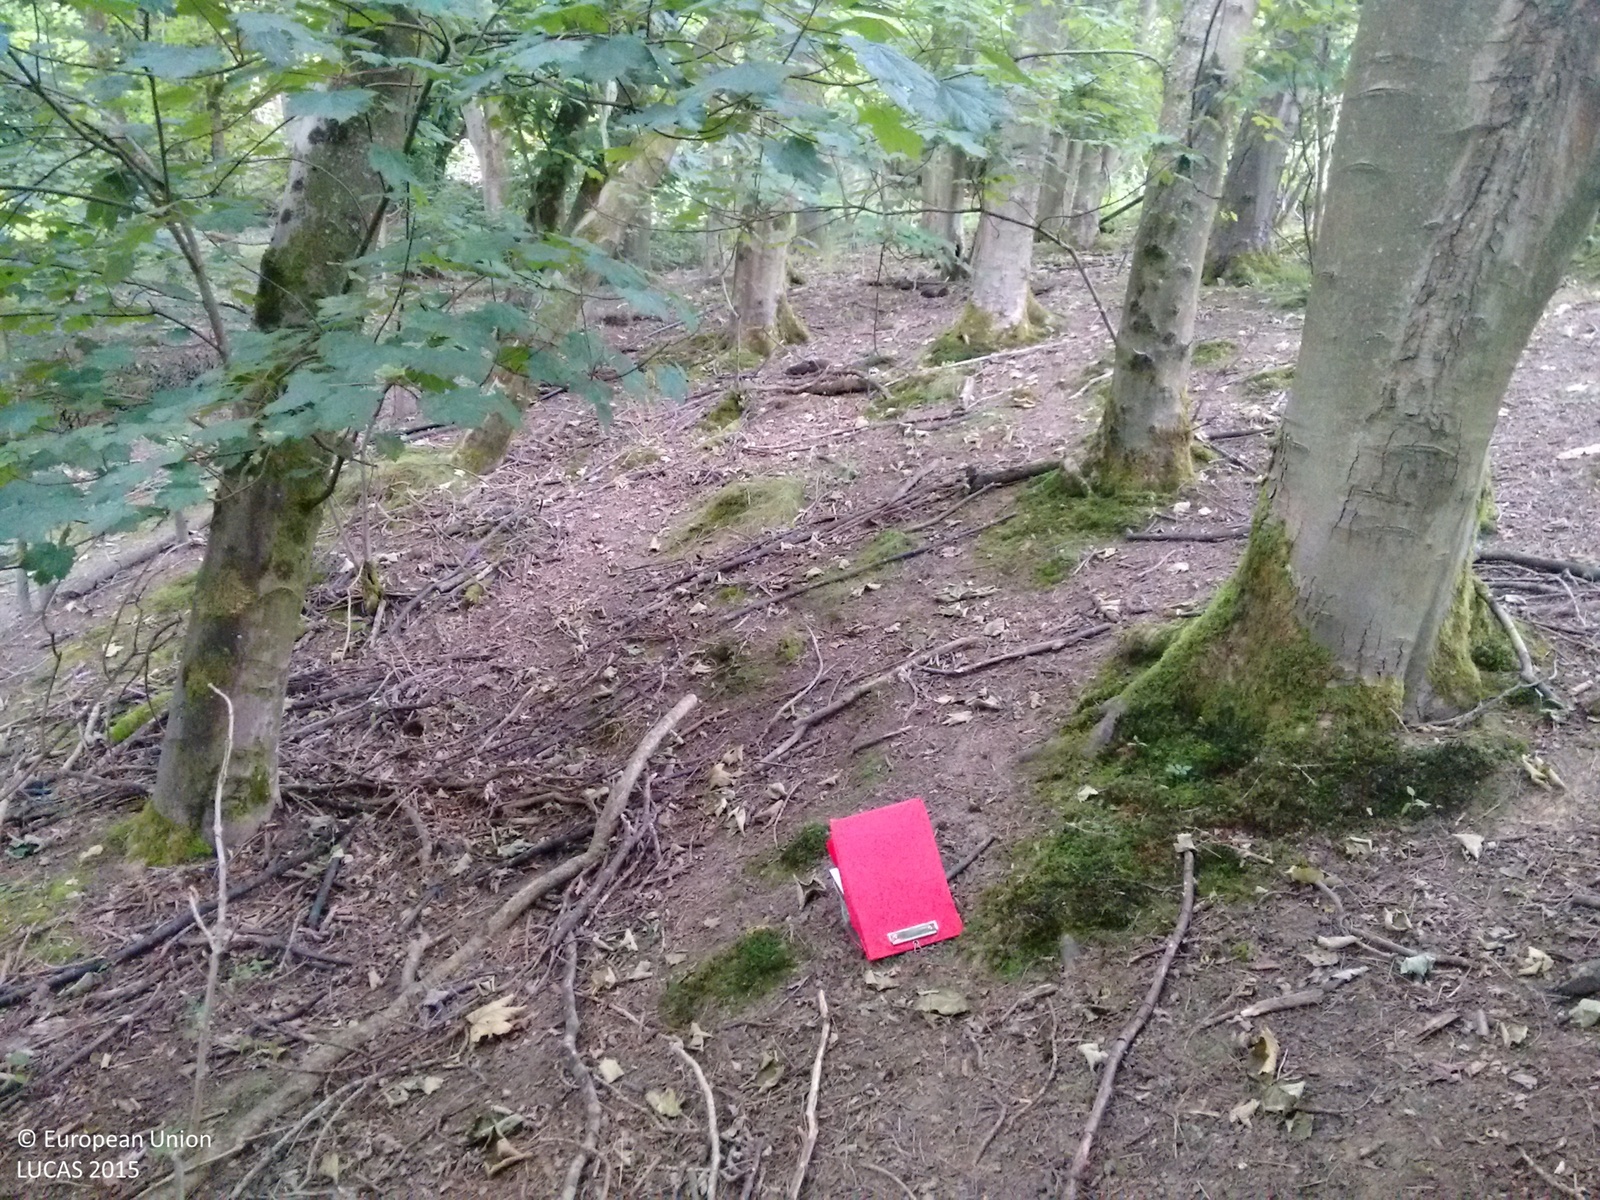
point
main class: Woodland
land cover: Broadleaved woodland
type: mesophytic deciduous forest
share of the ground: > 75 %
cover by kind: broadleaved forest trees 100 %
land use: Agriculture (excluding fallow land and kitchen gardens)
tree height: > 5 m
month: July
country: GB
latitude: 51.0608
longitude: -0.0642
